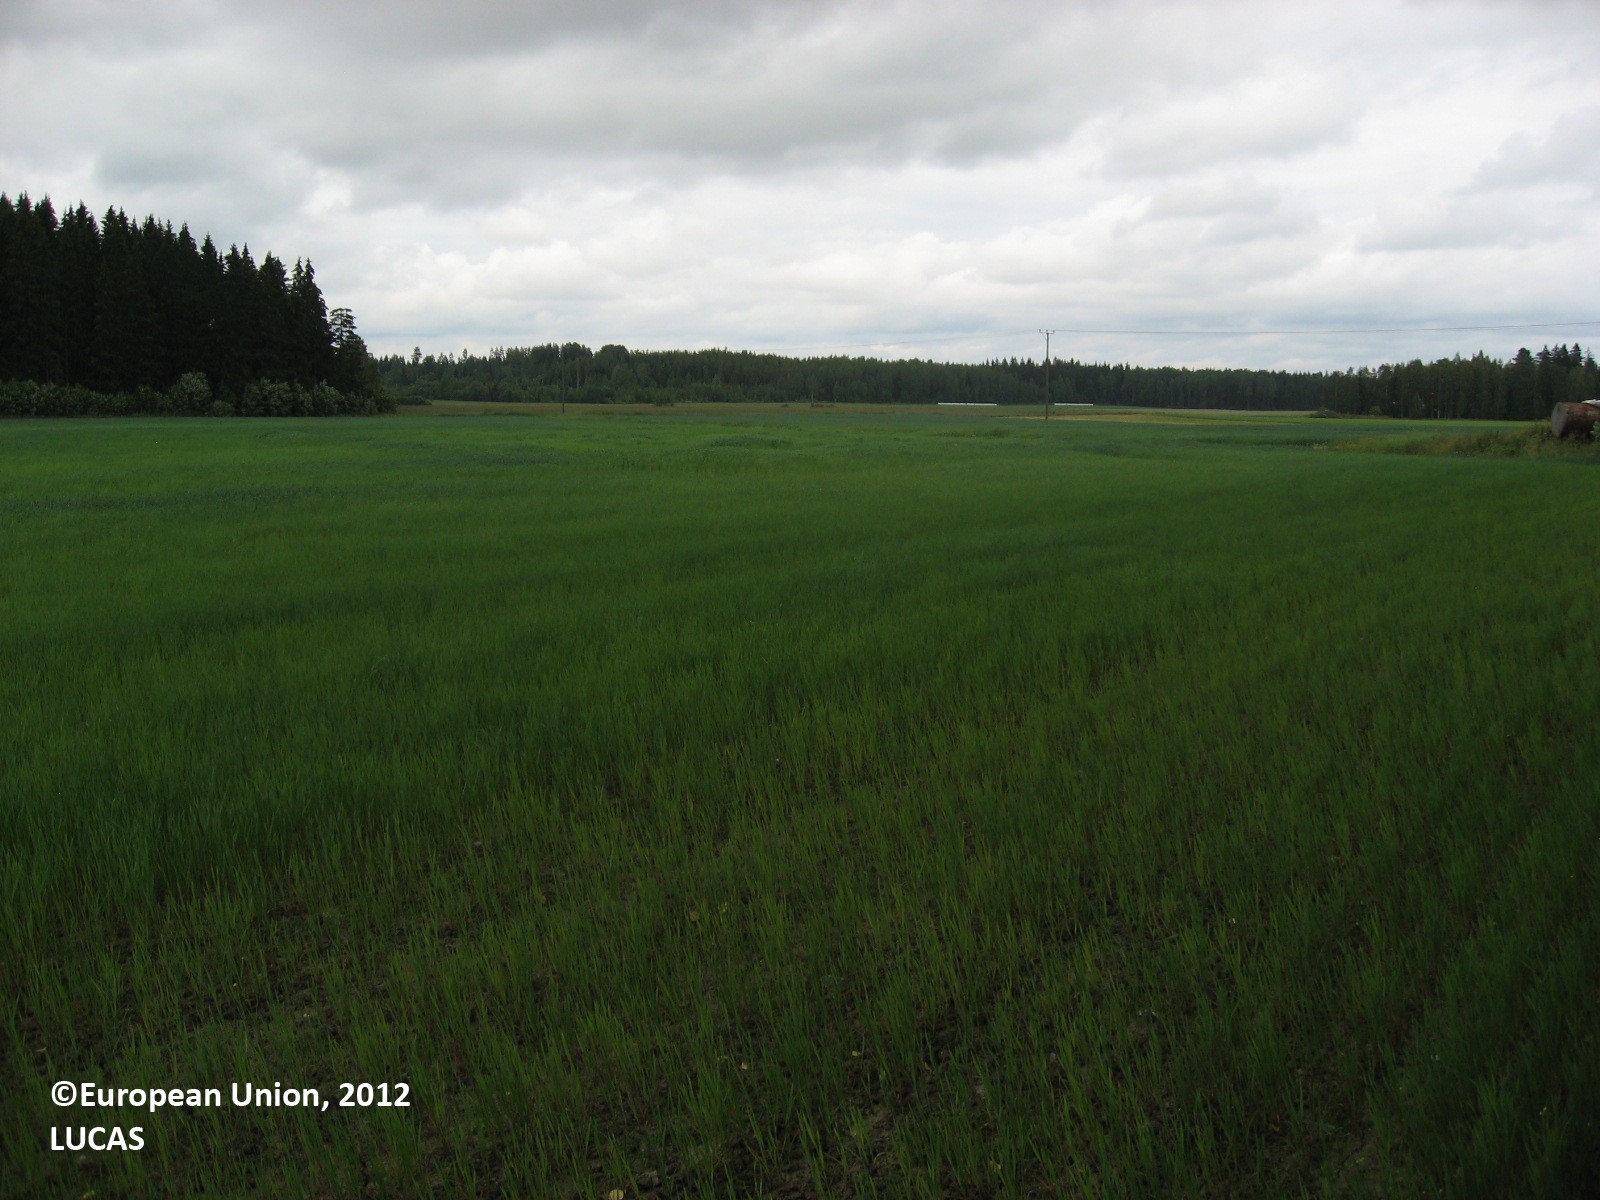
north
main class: Cropland
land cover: Oats
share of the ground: 50 - 75 %
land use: Agriculture (excluding fallow land and kitchen gardens)
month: July
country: FI
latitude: 60.8854
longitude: 25.6245
